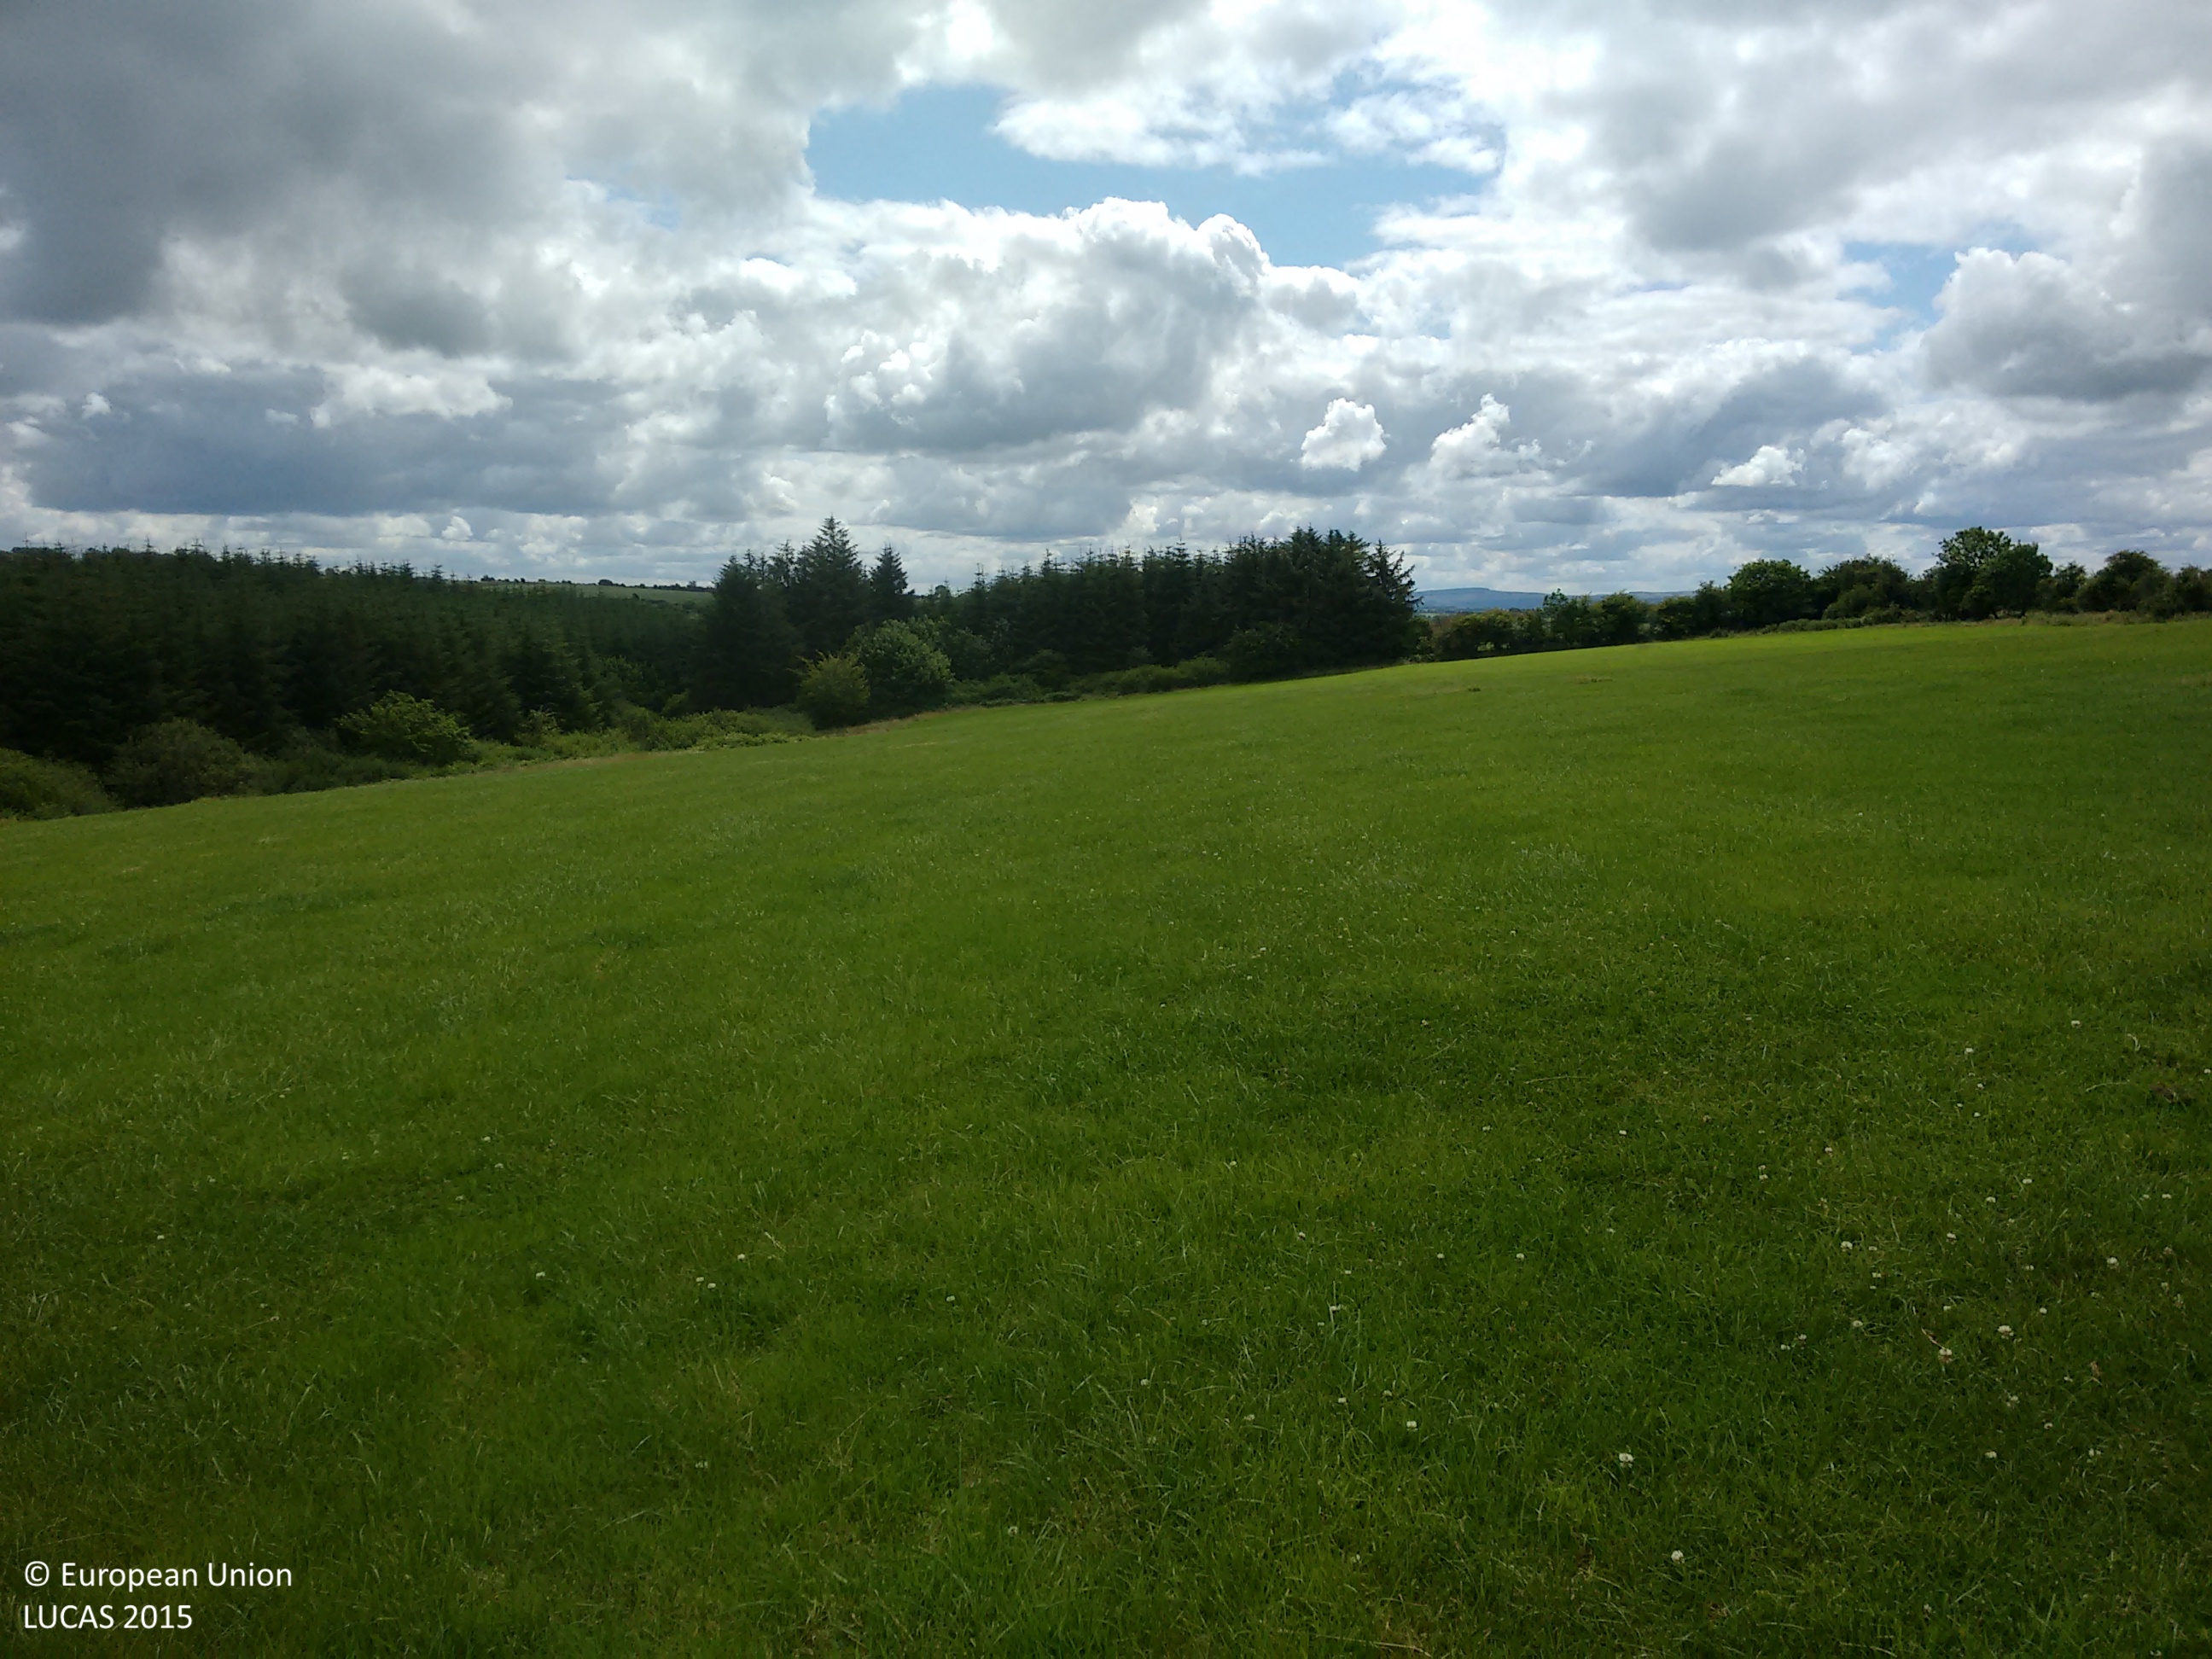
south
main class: Grassland
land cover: Grassland without tree/shrub cover
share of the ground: > 75 %
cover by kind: herbaceous plants 95 %, shrubs 5 %
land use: Agriculture (excluding fallow land and kitchen gardens)
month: July
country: IE
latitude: 52.2987
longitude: -8.9057
